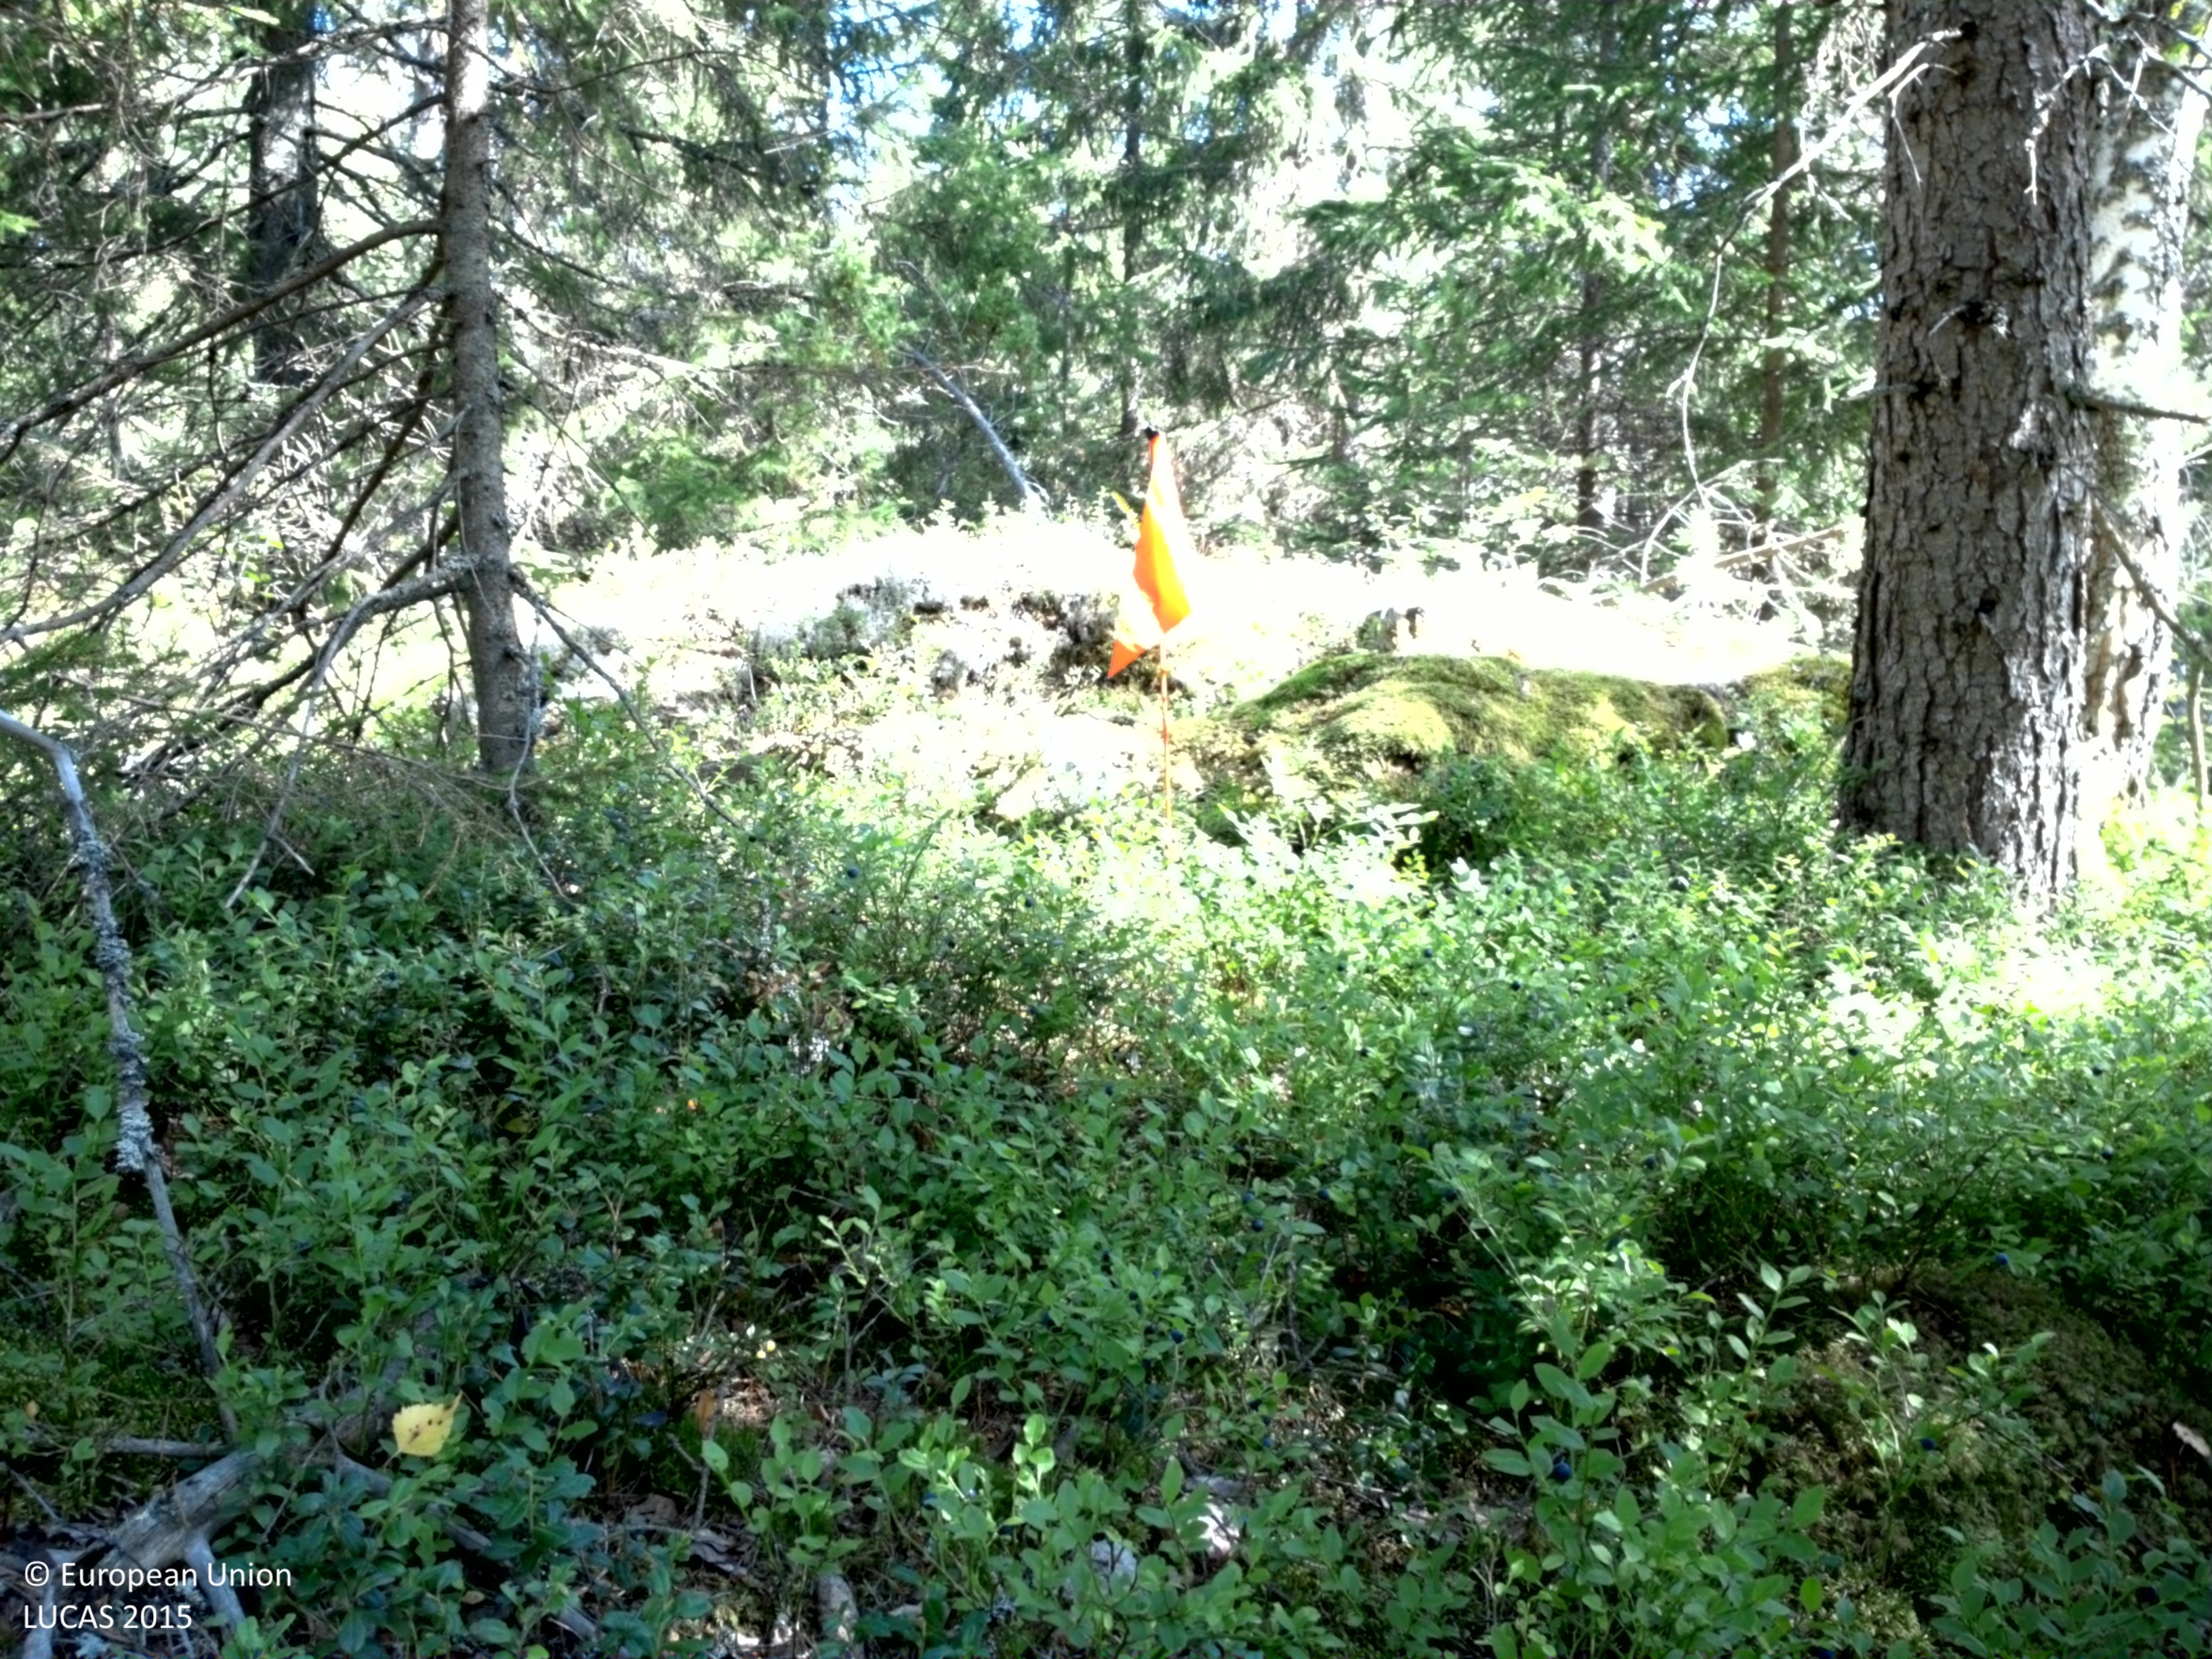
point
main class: Woodland
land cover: Spruce dominated coniferous woodland
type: boreal forest
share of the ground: > 75 %
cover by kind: coniferous forest trees 70 %, lichens and mosses 25 %, broadleaved forest trees 5 %
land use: Forestry
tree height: > 5 m
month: August
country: SE
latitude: 59.5452
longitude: 18.4723
